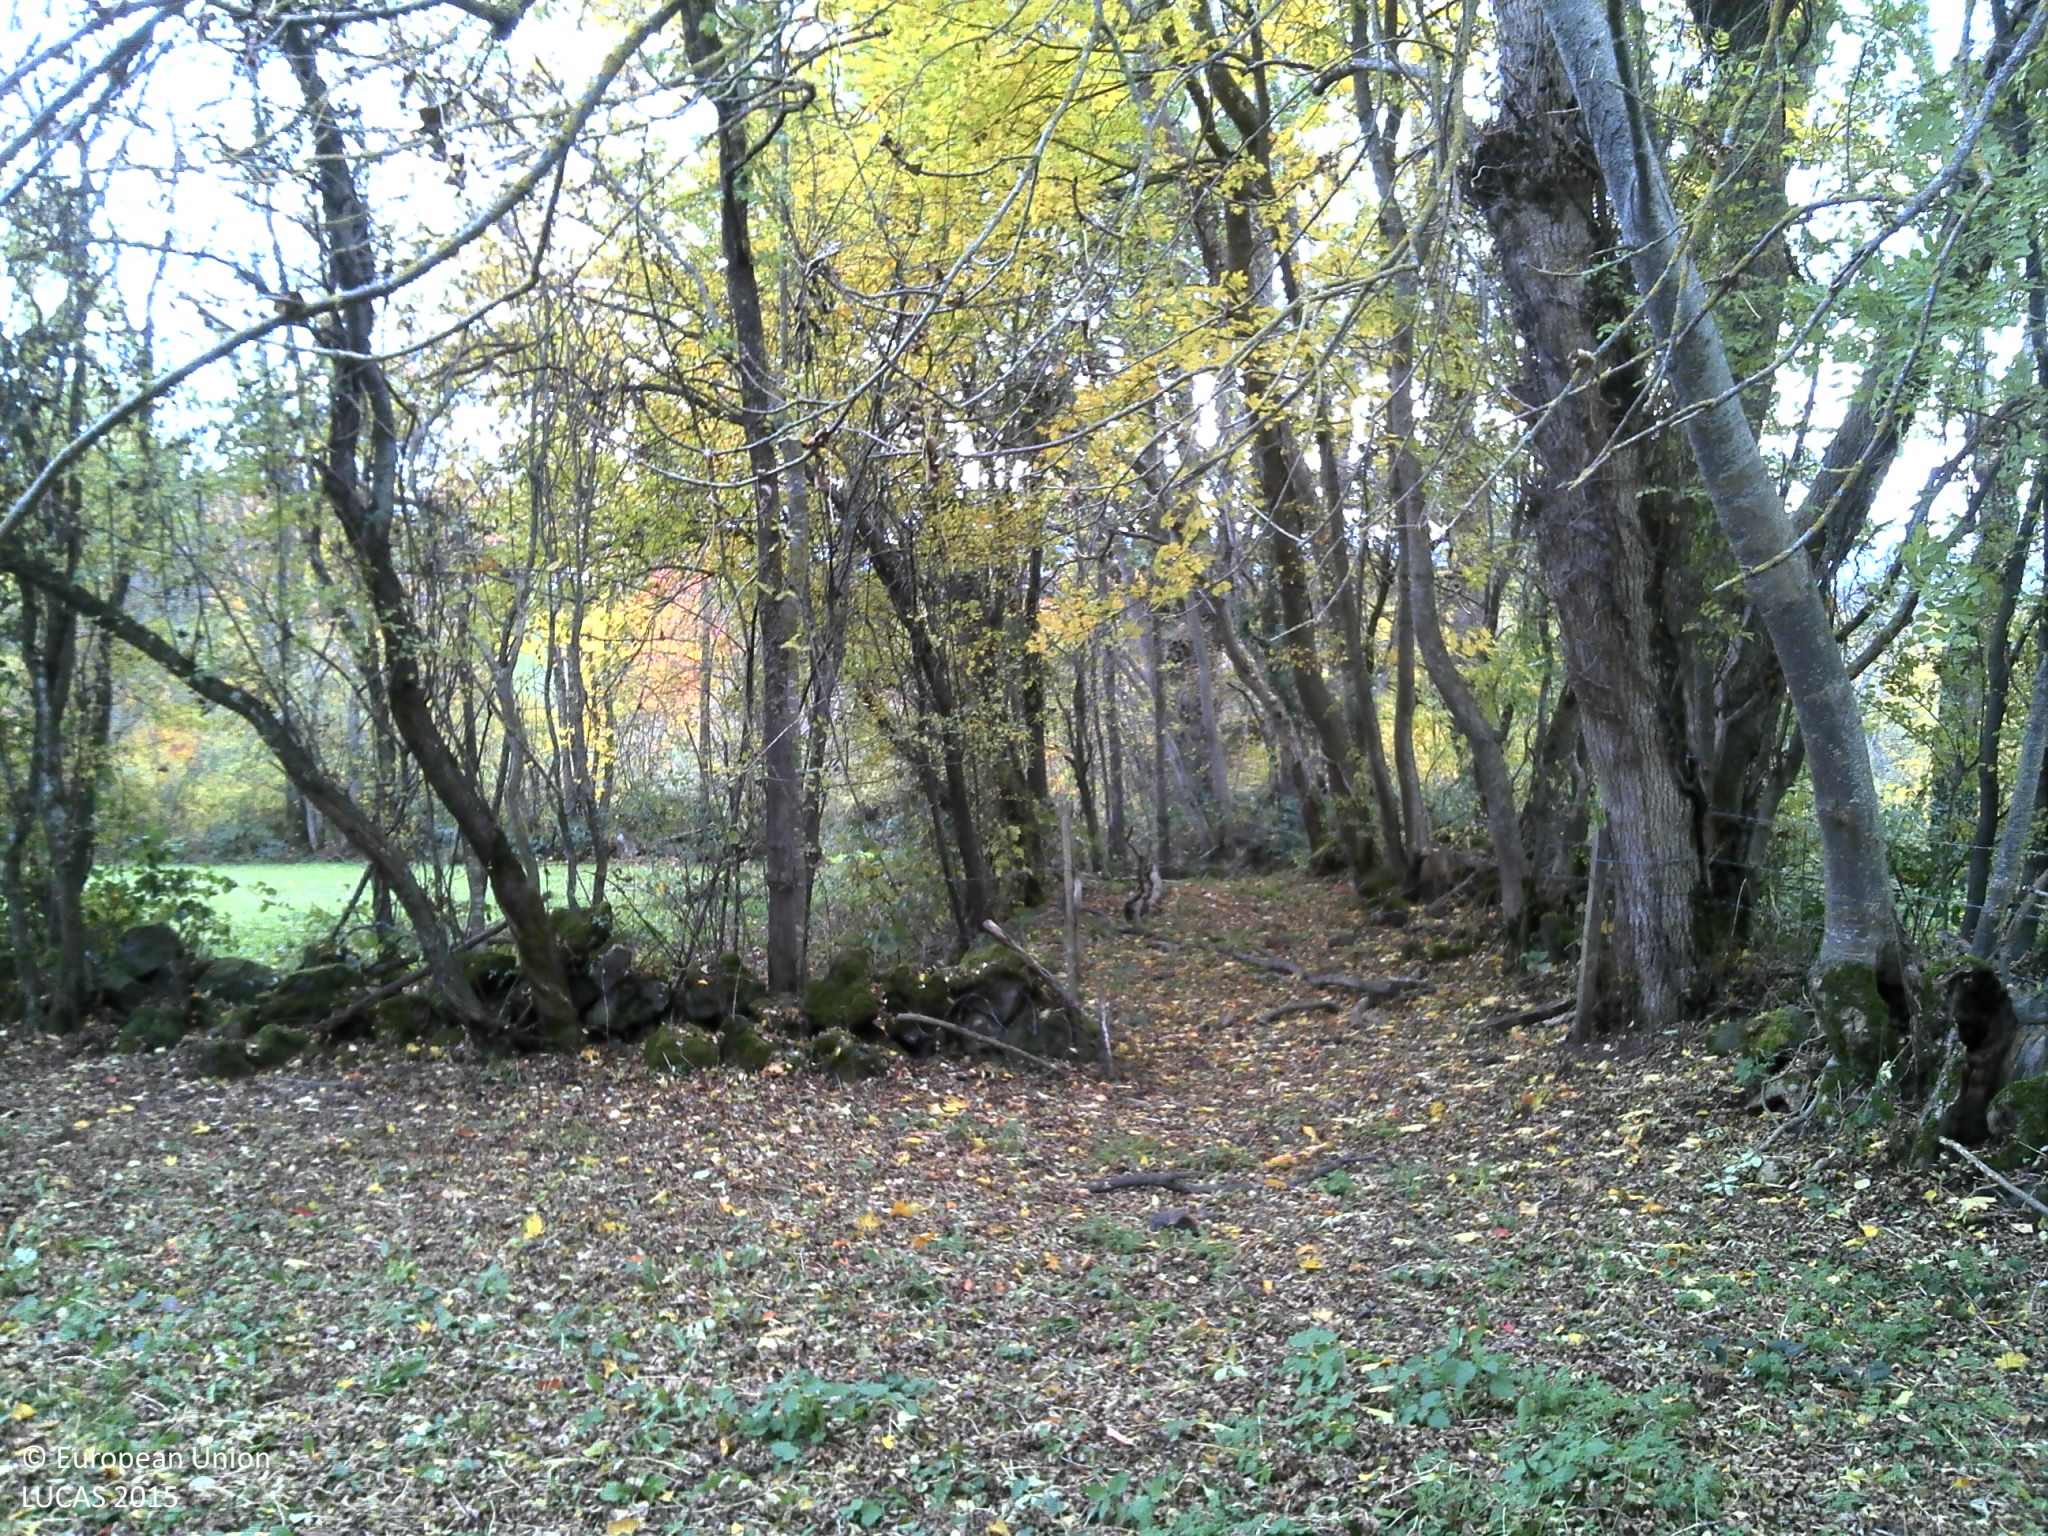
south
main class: Woodland
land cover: Broadleaved woodland
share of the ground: > 75 %
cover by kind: broadleaved forest trees 90 %, herbaceous plants 10 %
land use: Semi-natural and natural areas not in use
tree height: > 5 m
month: October
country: FR
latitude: 45.8049
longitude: 2.8575
